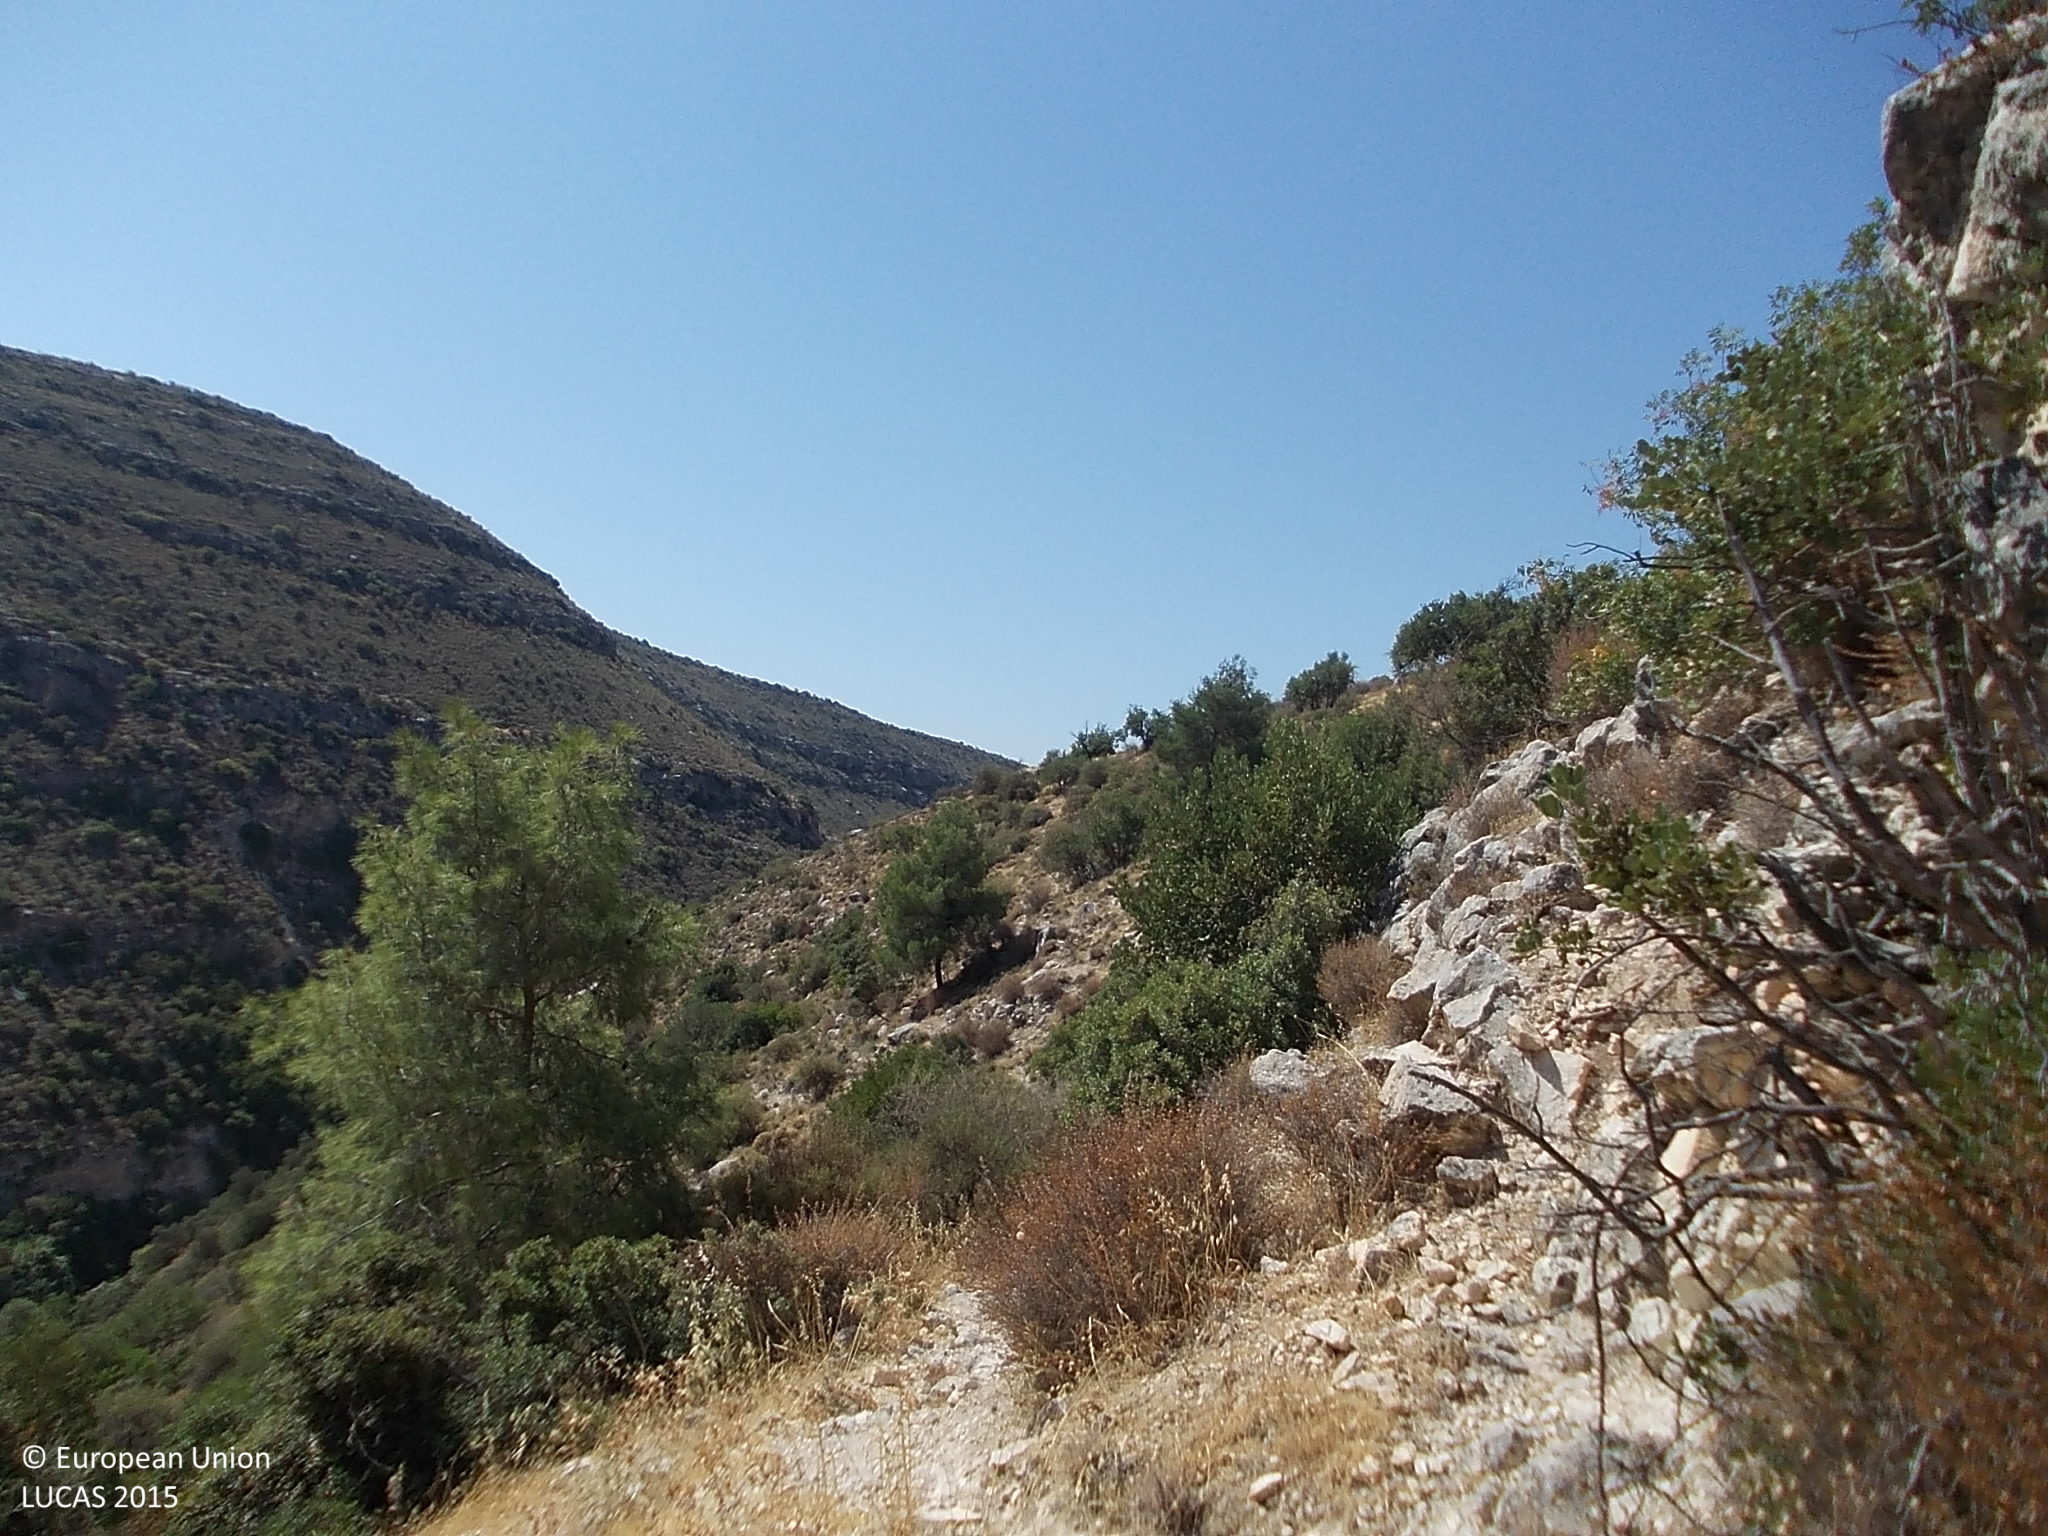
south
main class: Shrubland
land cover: Shrubland without tree cover
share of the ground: 50 - 75 %
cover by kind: shrubs 60 %, unconsolidated bare surface 20 %, herbaceous plants 10 %, consolidated bare surface 10 %
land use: Semi-natural and natural areas not in use
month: September
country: CY
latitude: 34.7331
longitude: 32.7972
